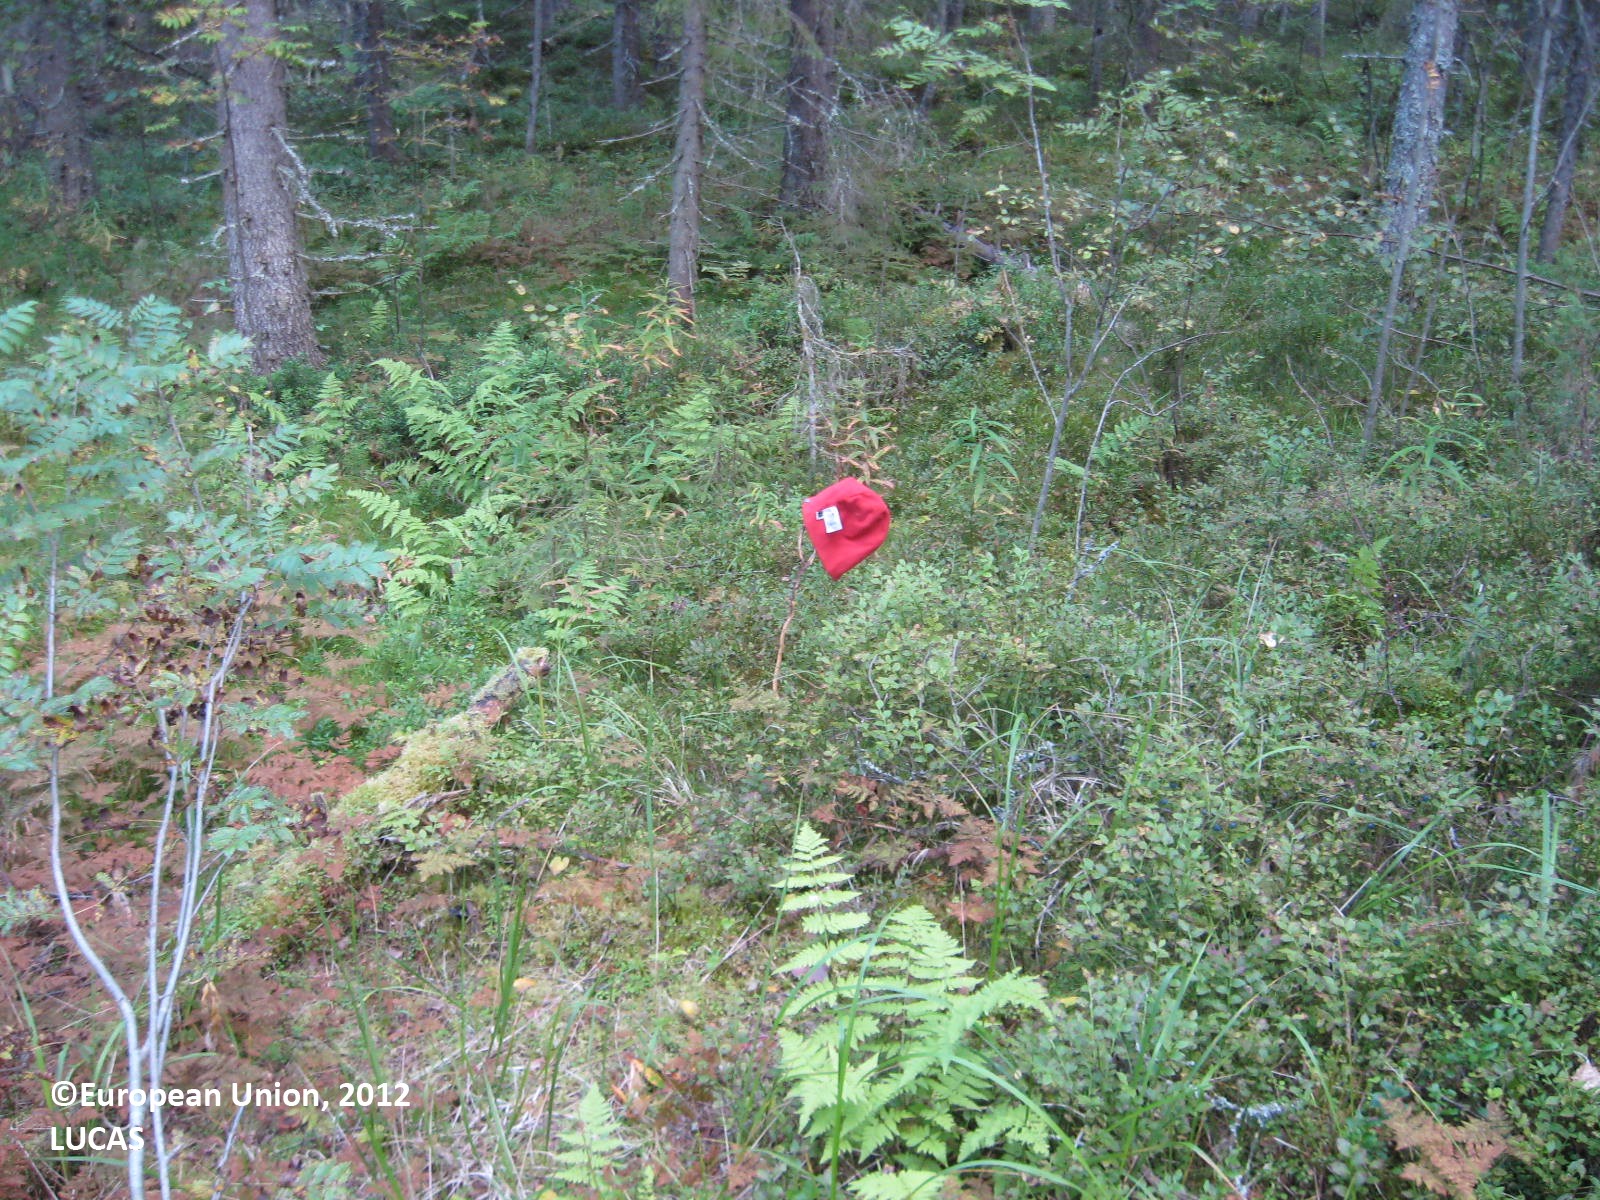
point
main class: Woodland
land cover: Other coniferous woodland
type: boreal forest
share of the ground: 50 - 75 %
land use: Forestry
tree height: > 5 m
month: August
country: FI
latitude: 63.7344
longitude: 29.3162
